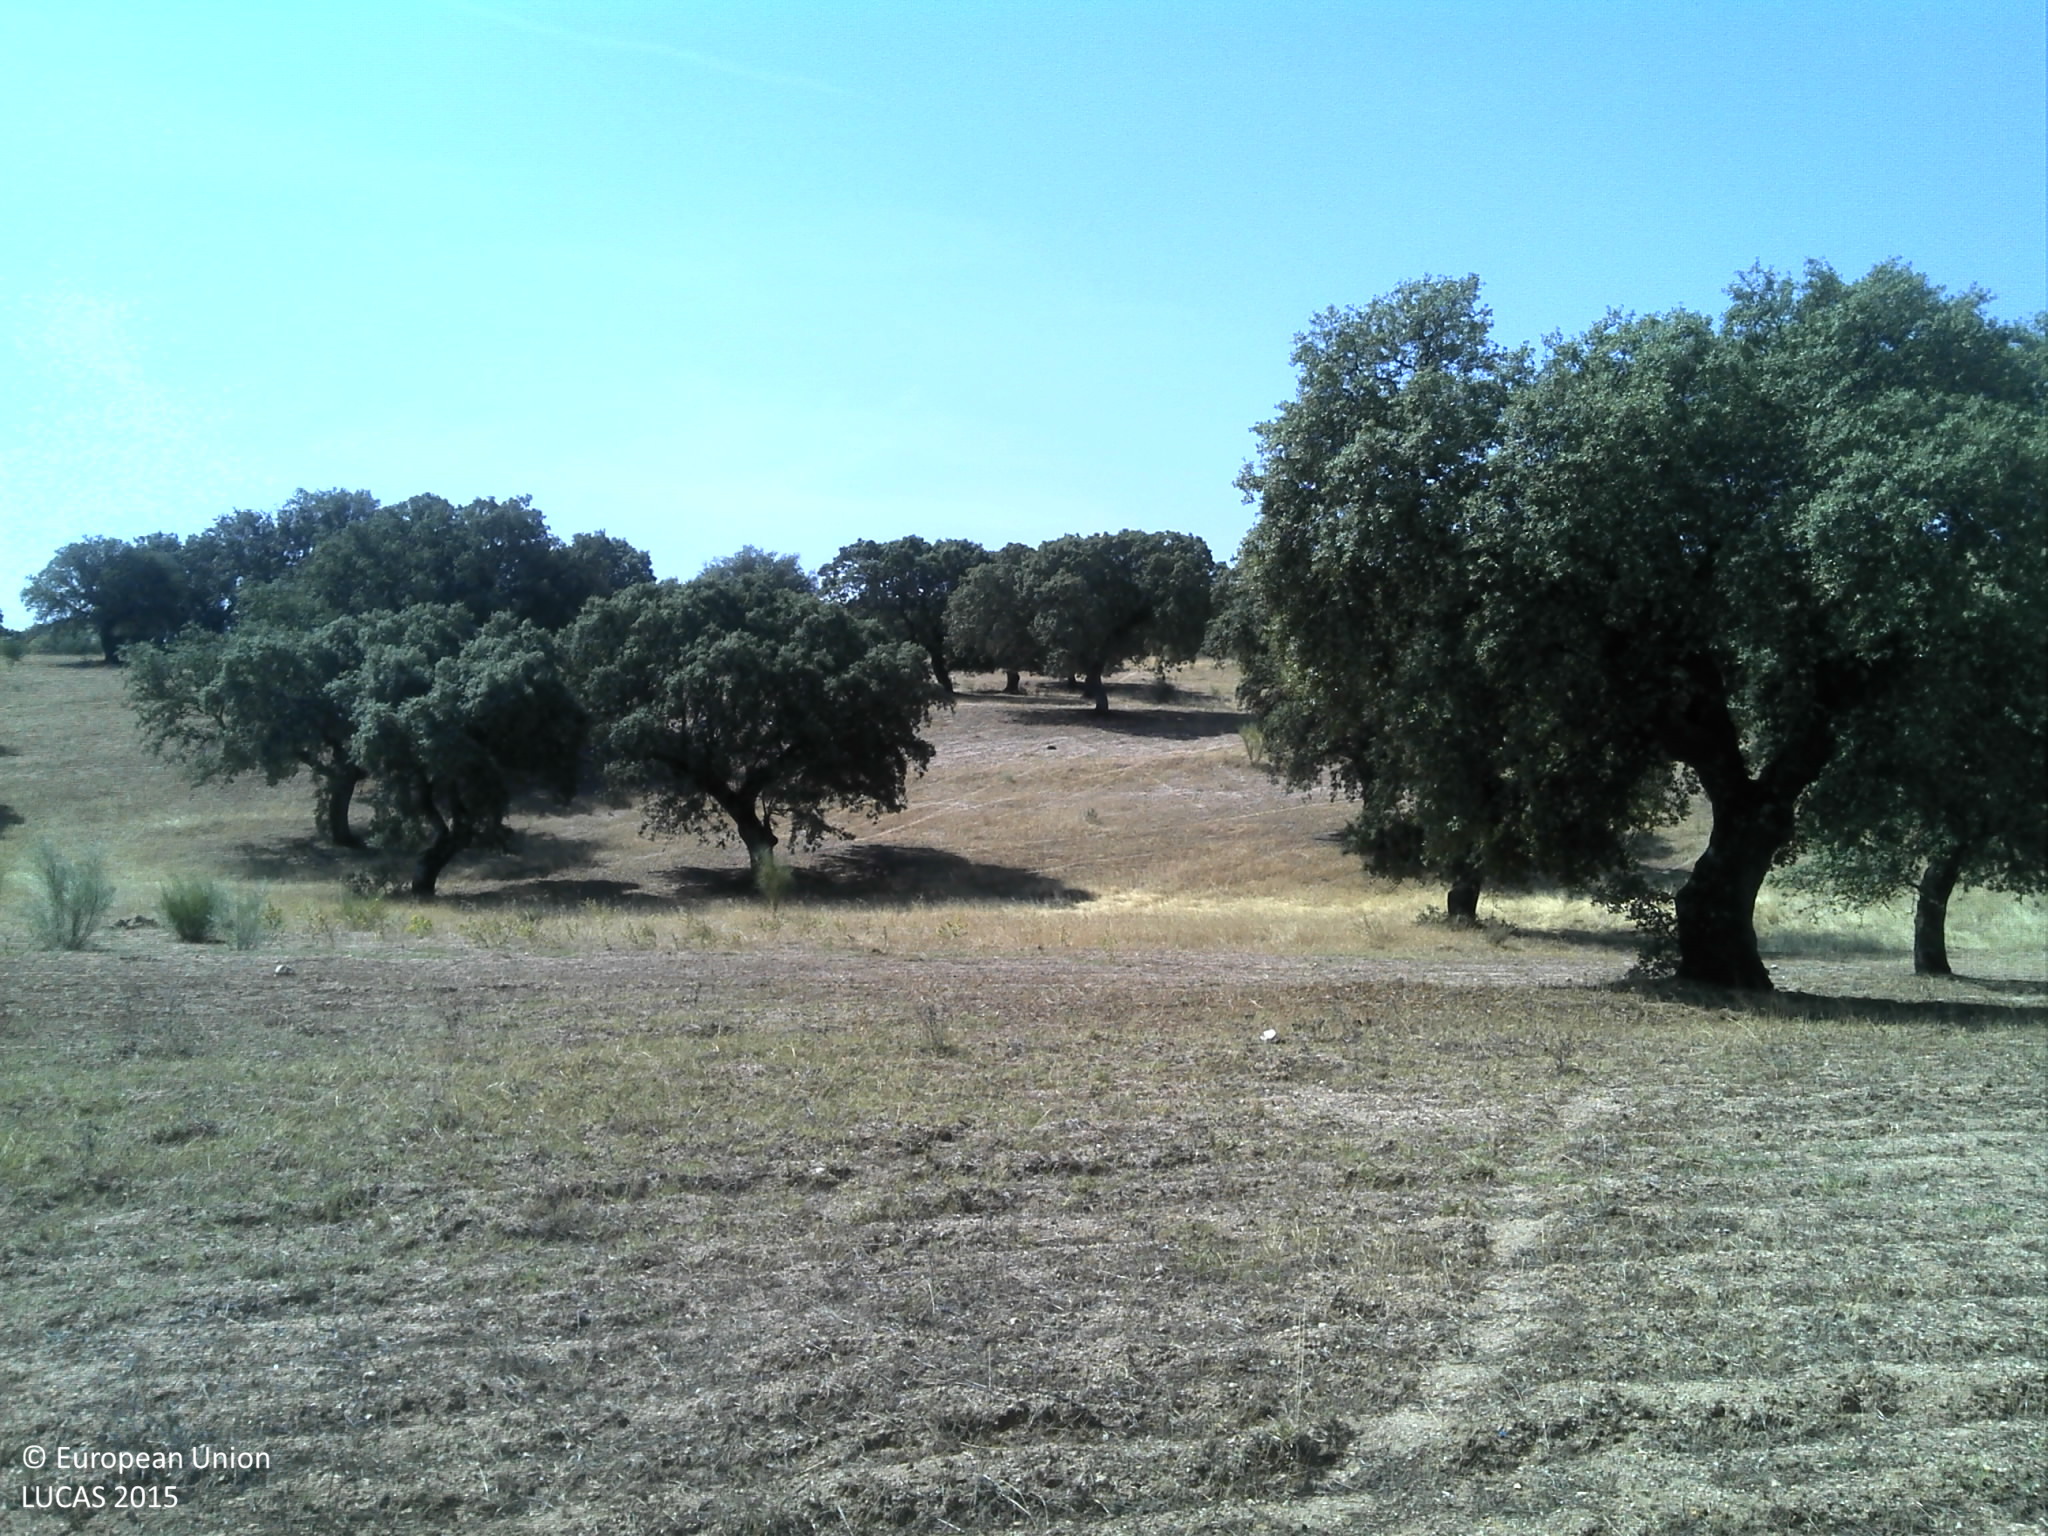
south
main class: Woodland
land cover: Broadleaved woodland
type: broadleaved evergreen forest
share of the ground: 25 - 50 %
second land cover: Spontaneously vegetated surfaces
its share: 25 - 50 %
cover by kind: broadleaved forest trees 40 %, herbaceous plants 30 %, unconsolidated bare surface 25 %
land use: Forestry
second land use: Agriculture (excluding fallow land and kitchen gardens)
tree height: > 5 m
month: June
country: PT
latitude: 39.8820
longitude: -7.0805
